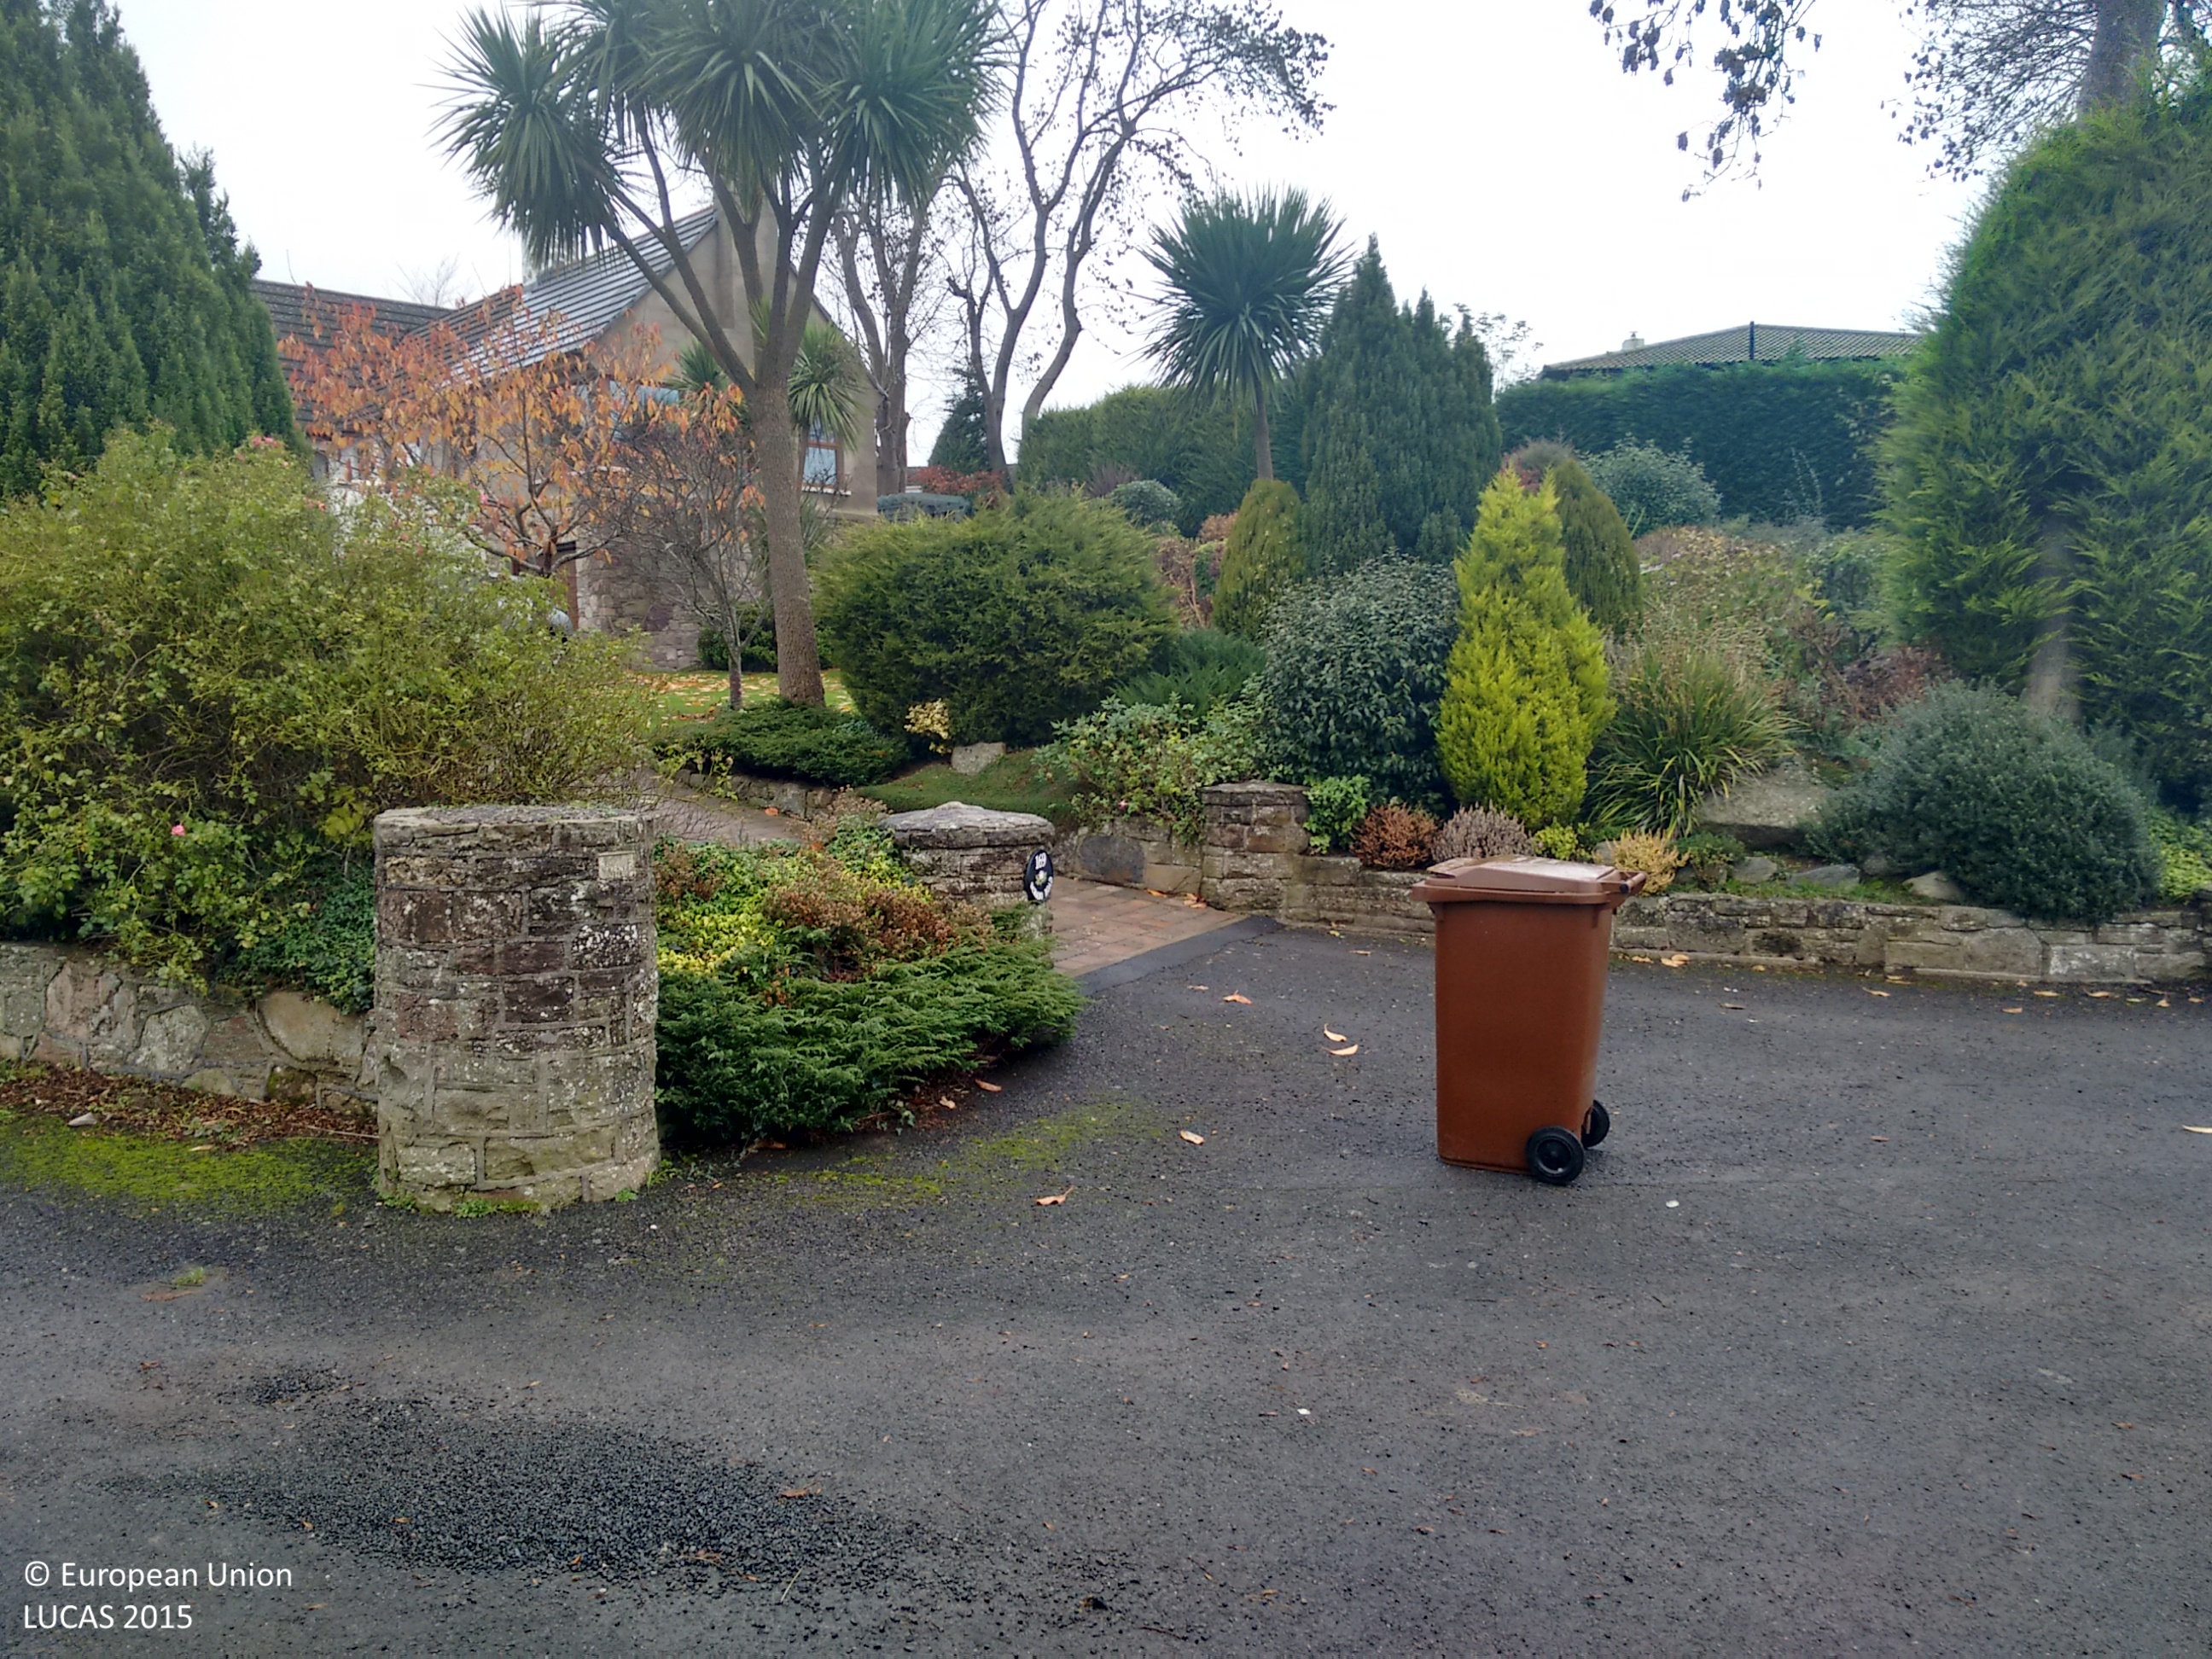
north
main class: Grassland
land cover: Grassland without tree/shrub cover
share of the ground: > 75 %
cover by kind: herbaceous plants 100 %
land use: Agriculture (excluding fallow land and kitchen gardens)
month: November
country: GB
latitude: 54.5862
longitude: -5.7152
